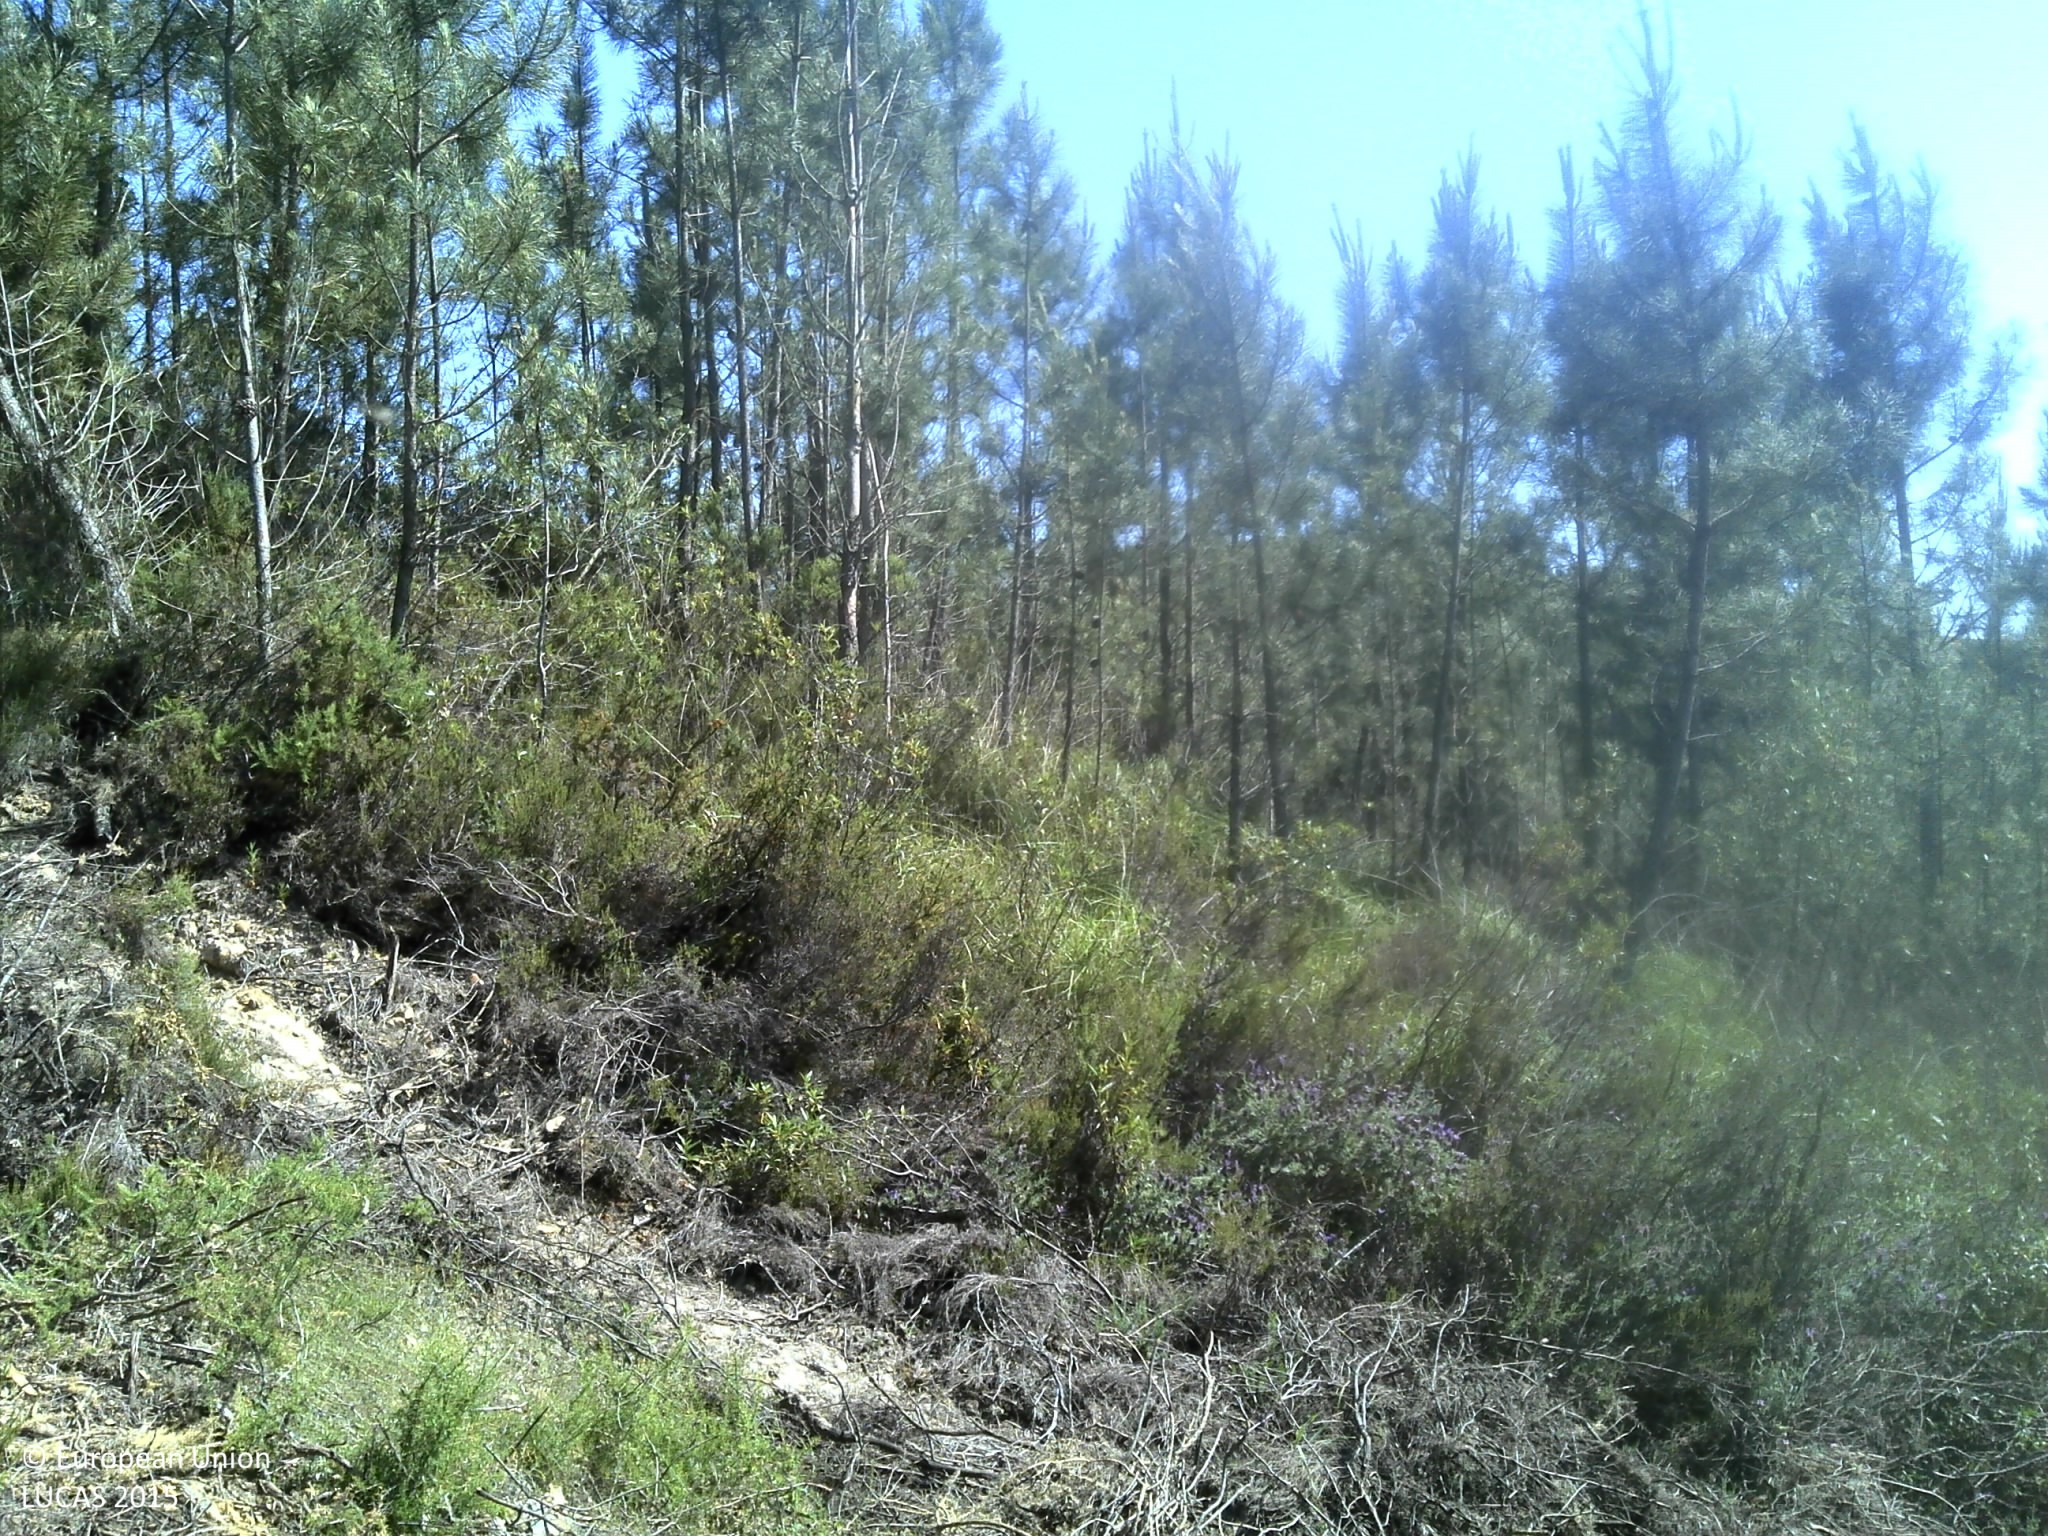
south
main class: Shrubland
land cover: Shrubland with sparse tree cover
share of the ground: 50 - 75 %
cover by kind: shrubs 75 %, unconsolidated bare surface 15 %, broadleaved forest trees 5 %, herbaceous plants 5 %
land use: Abandoned areas
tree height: > 5 m
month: May
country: PT
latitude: 39.5113
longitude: -8.3882
